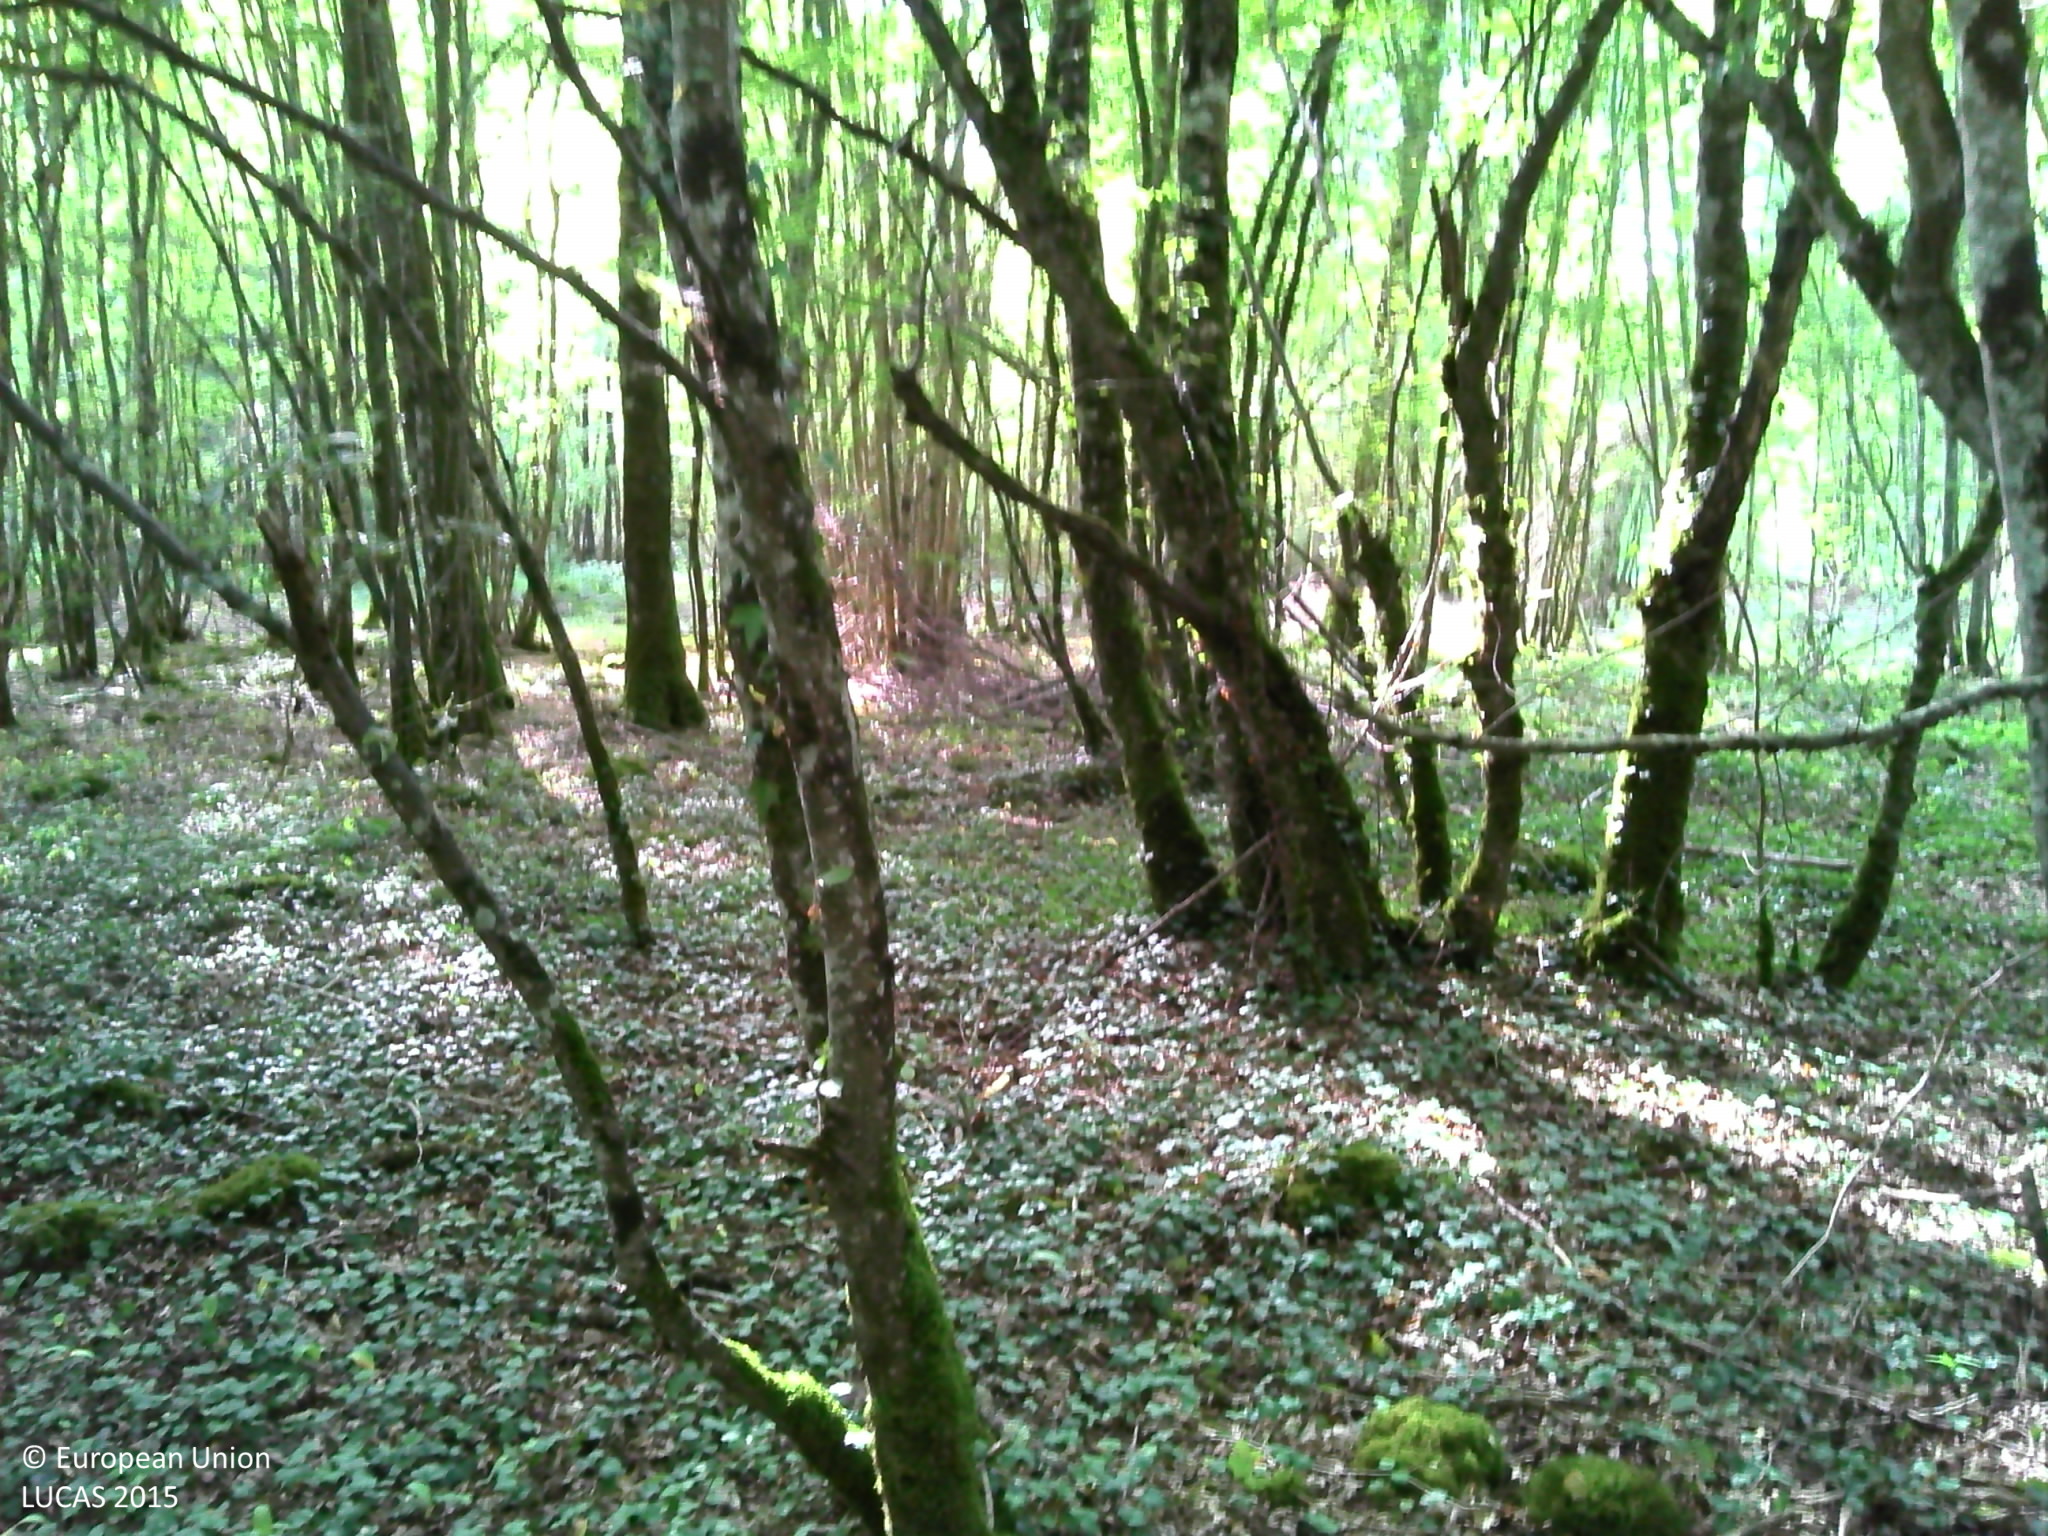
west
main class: Woodland
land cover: Broadleaved woodland
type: mesophytic deciduous forest
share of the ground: > 75 %
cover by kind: broadleaved forest trees 90 %, herbaceous plants 5 %, lichens and mosses 5 %
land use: Forestry
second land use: Amenities, museums, leisure
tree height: > 5 m
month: August
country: FR
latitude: 47.7168
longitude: 3.0757
